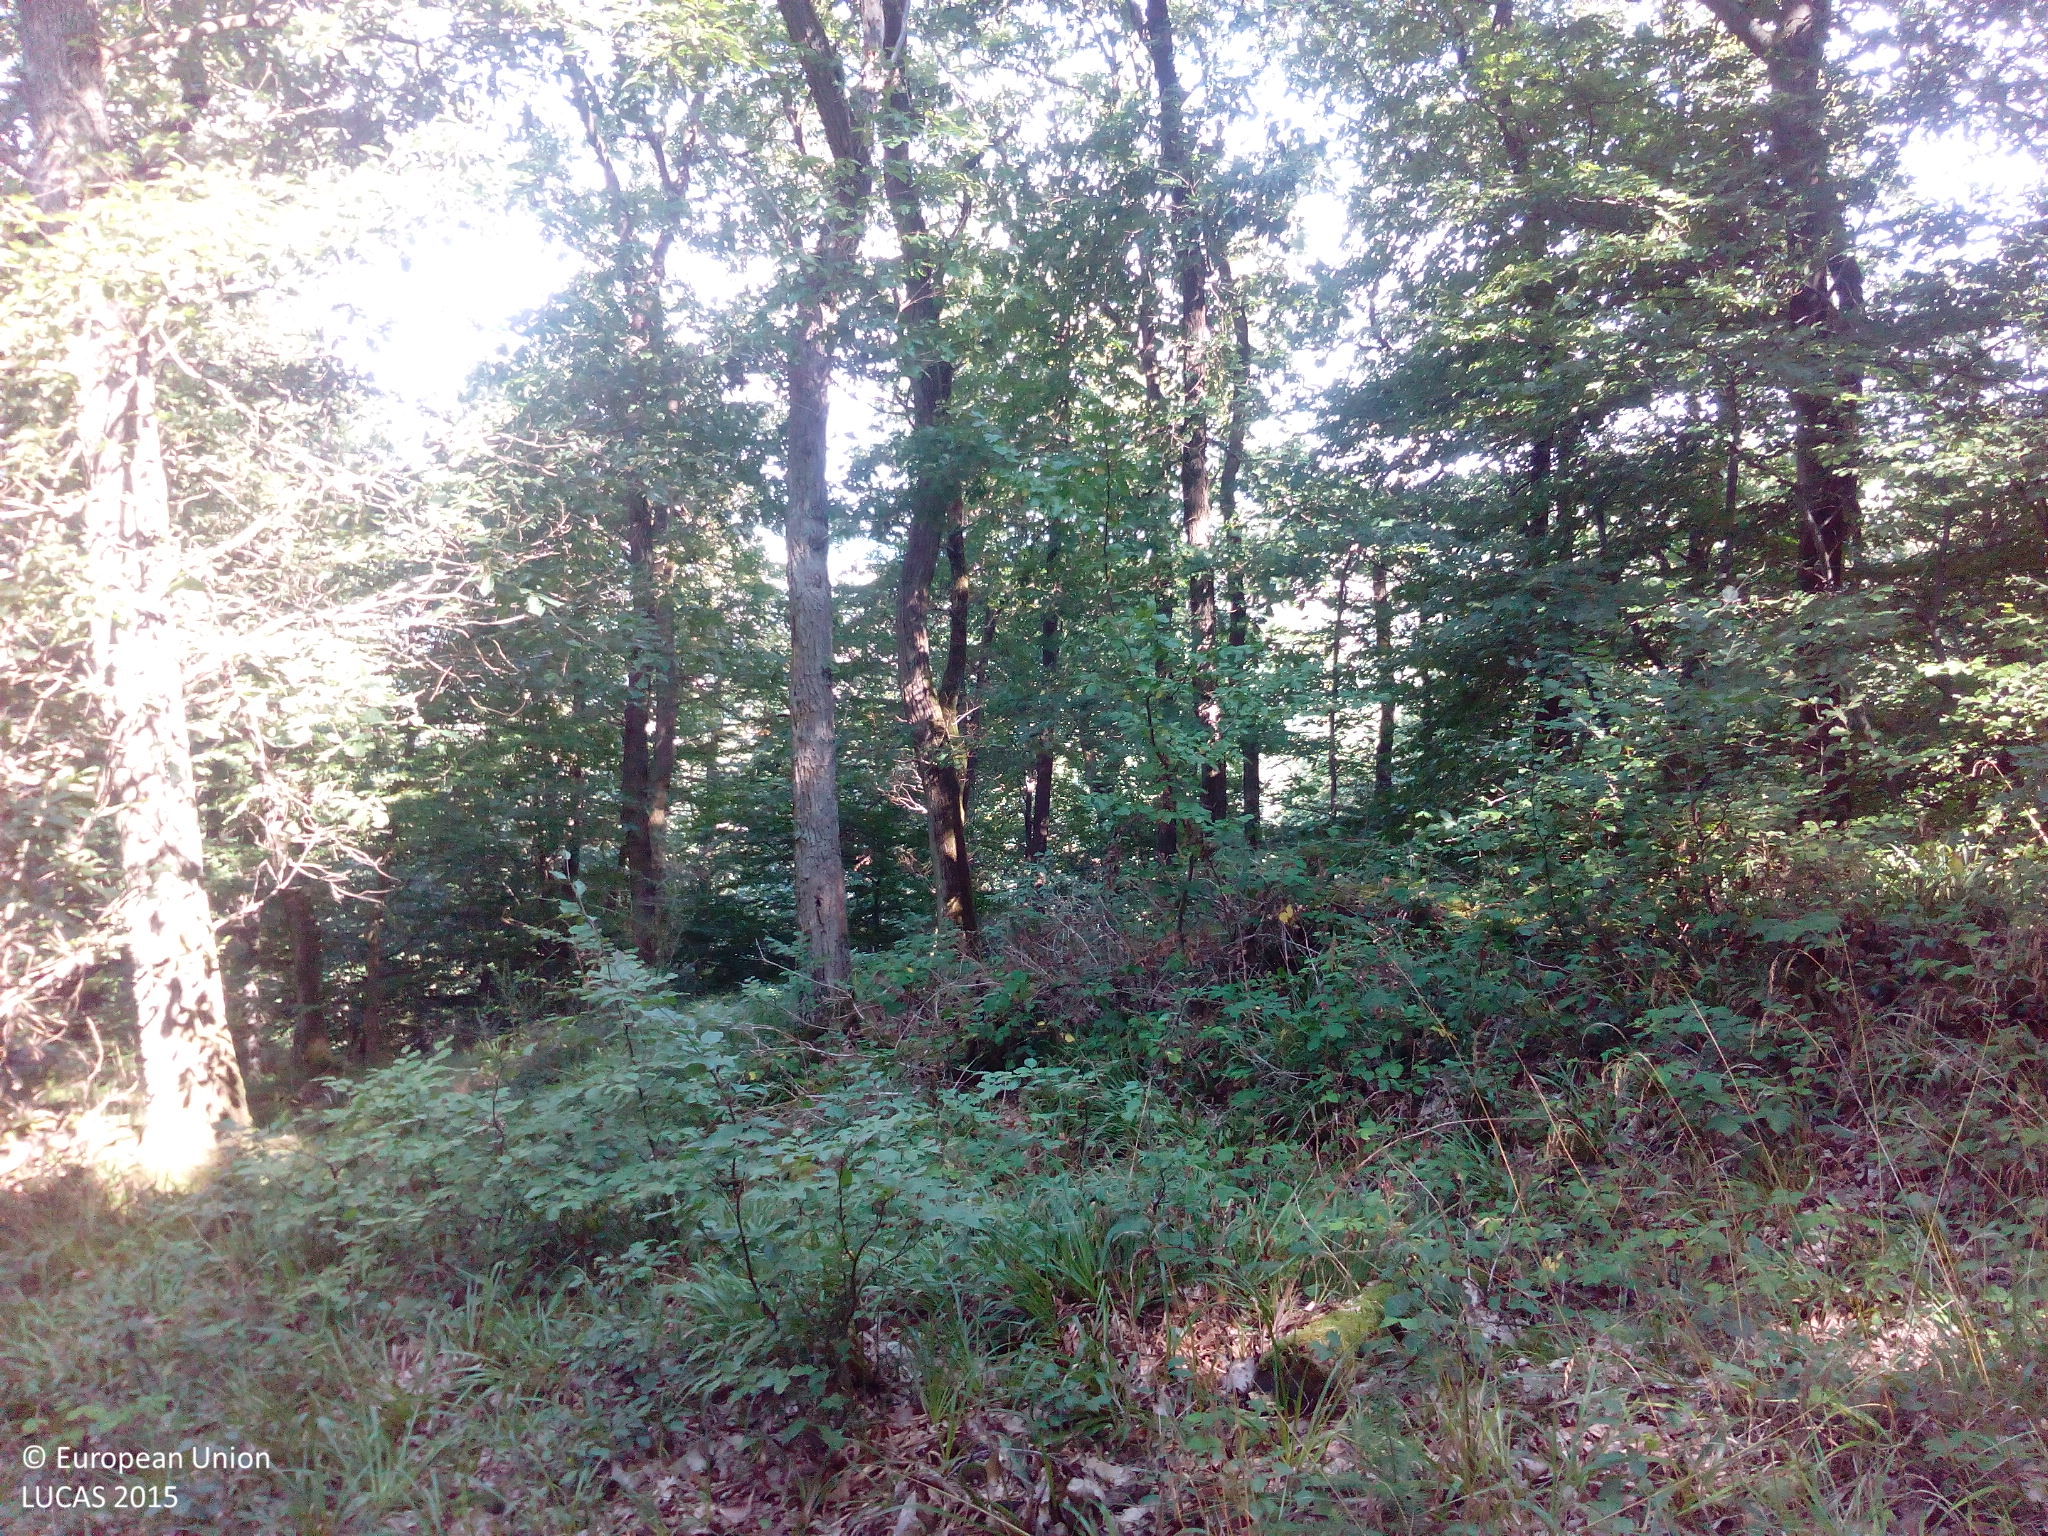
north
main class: Woodland
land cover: Broadleaved woodland
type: mesophytic deciduous forest
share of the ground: > 75 %
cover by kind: broadleaved forest trees 80 %, unconsolidated bare surface 10 %, herbaceous plants 5 %, lichens and mosses 5 %
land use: Forestry
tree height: > 5 m
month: August
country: DE
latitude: 50.2639
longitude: 7.4611
